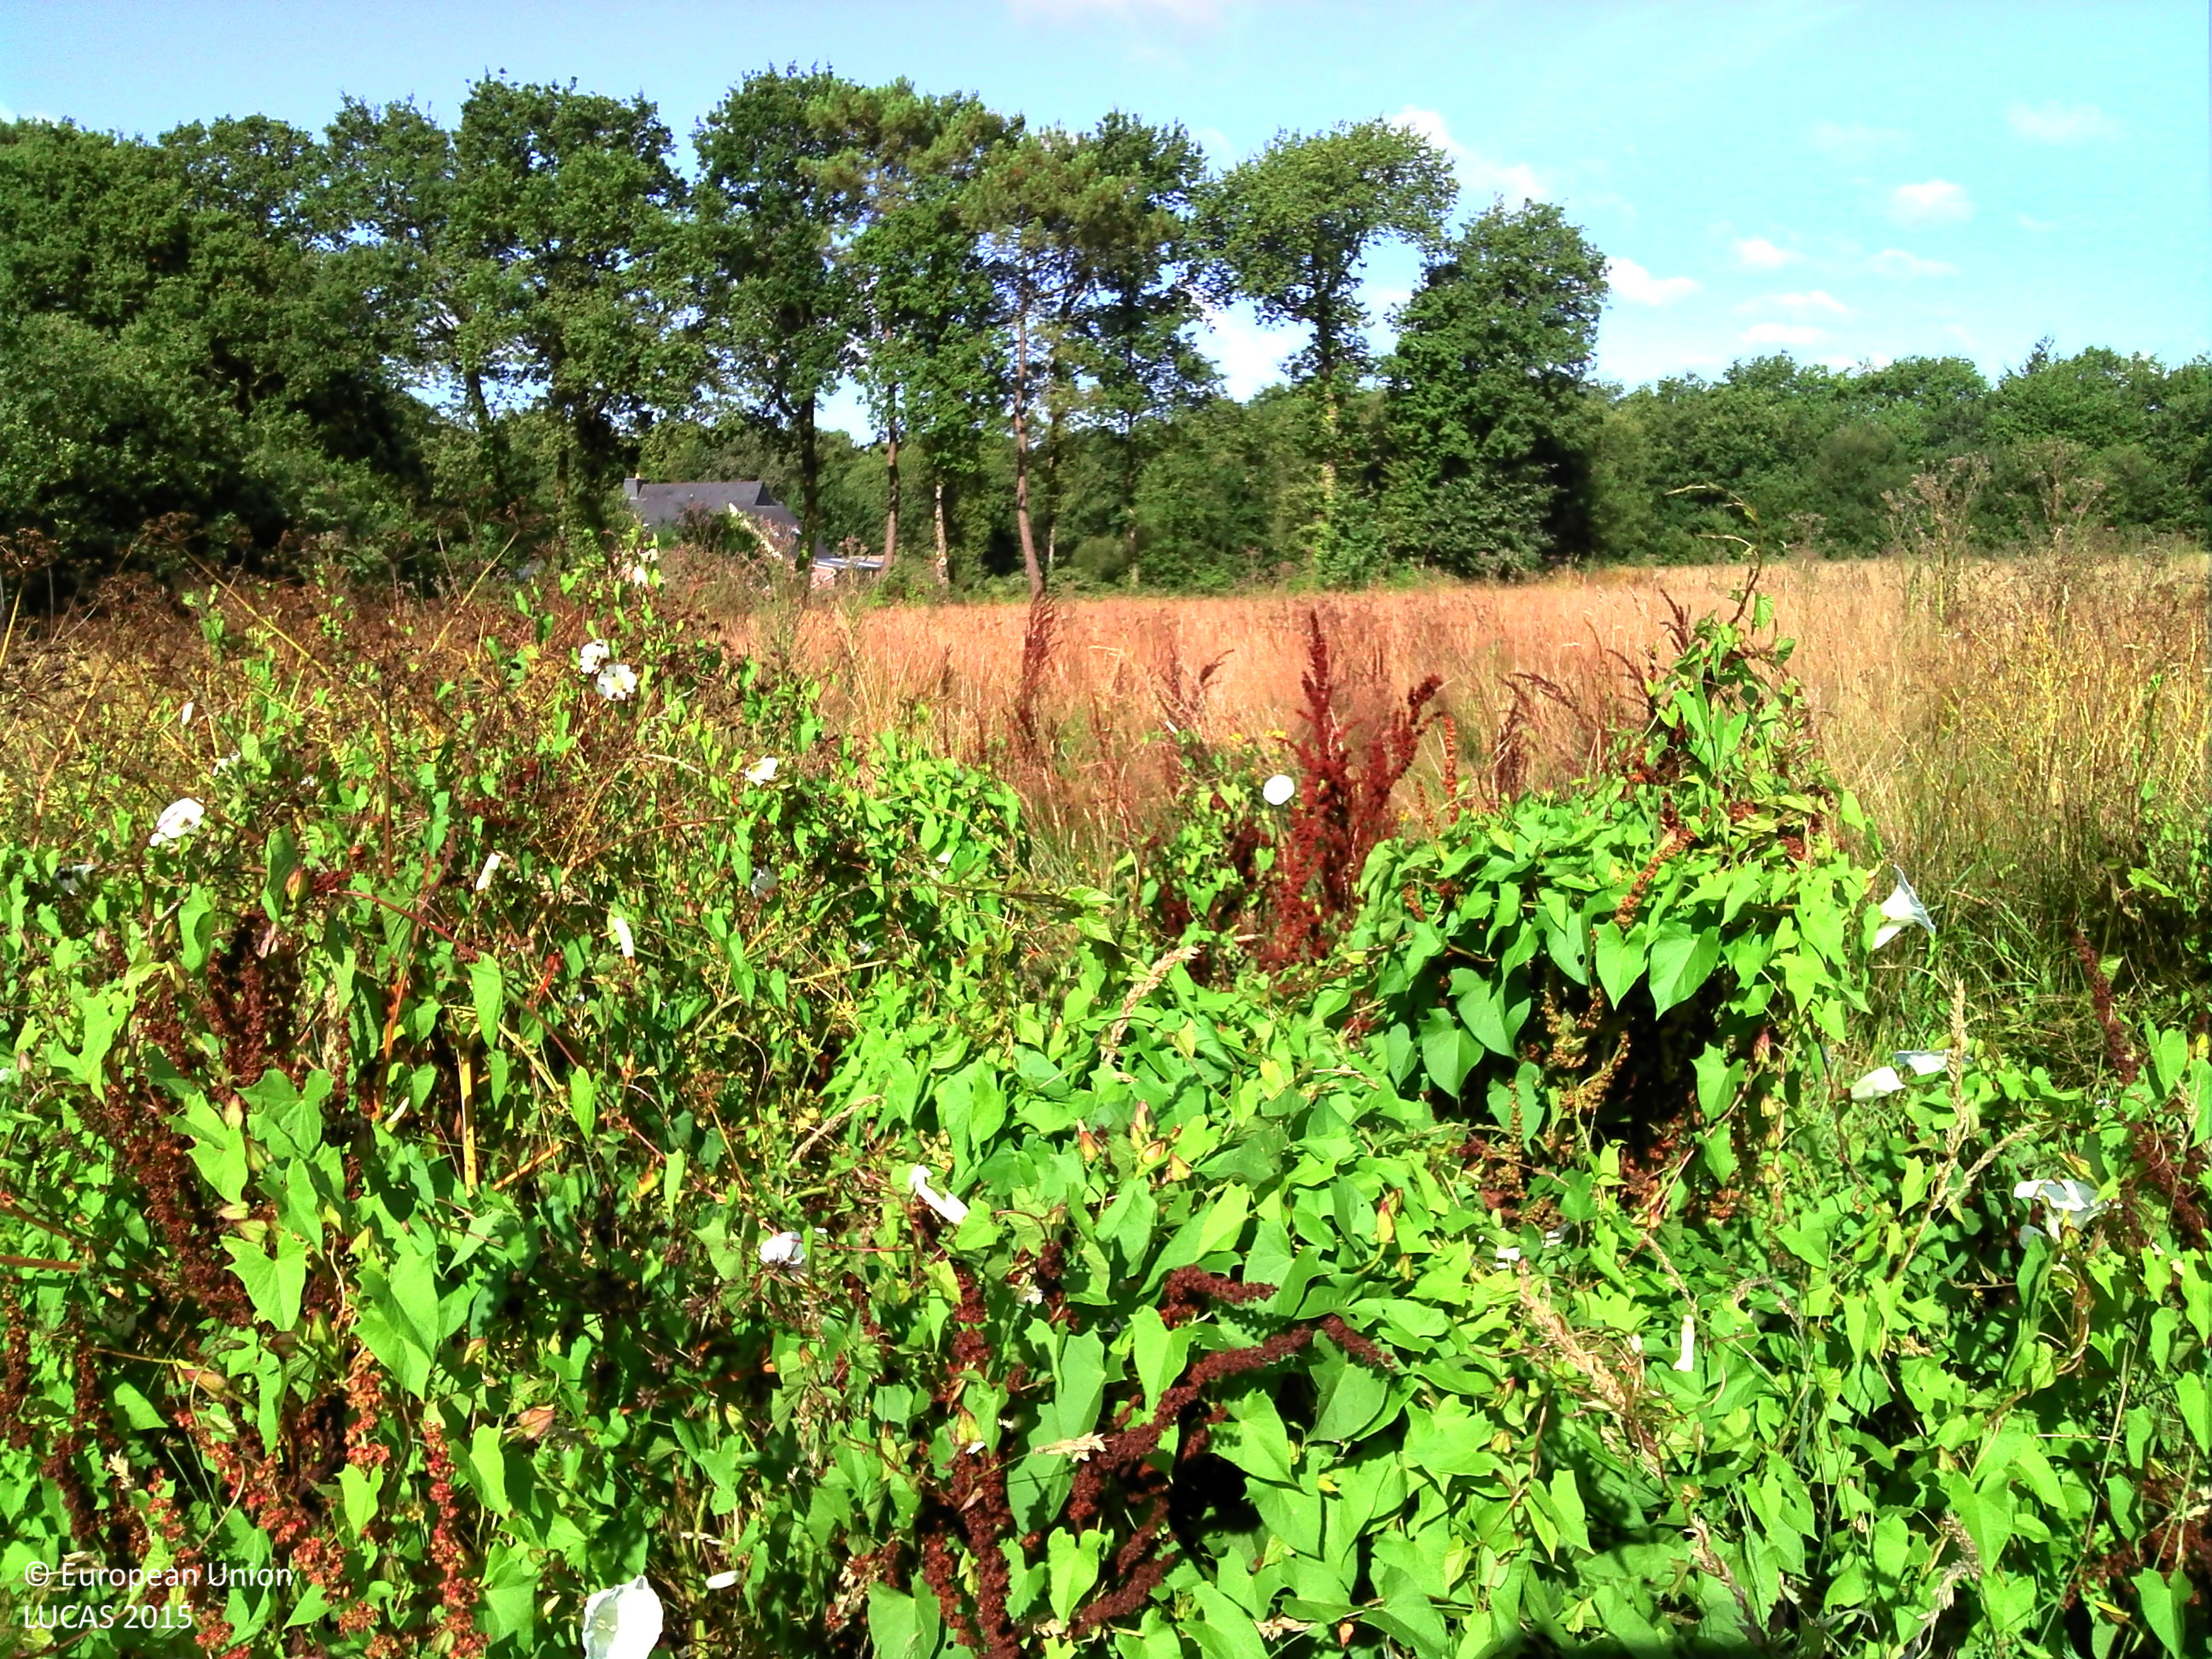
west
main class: Grassland
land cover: Spontaneously vegetated surfaces
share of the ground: > 75 %
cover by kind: herbaceous plants 80 %, consolidated bare surface 10 %, unconsolidated bare surface 10 %
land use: Fallow land
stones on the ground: < 10 %
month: July
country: FR
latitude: 47.7830
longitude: -3.1084
